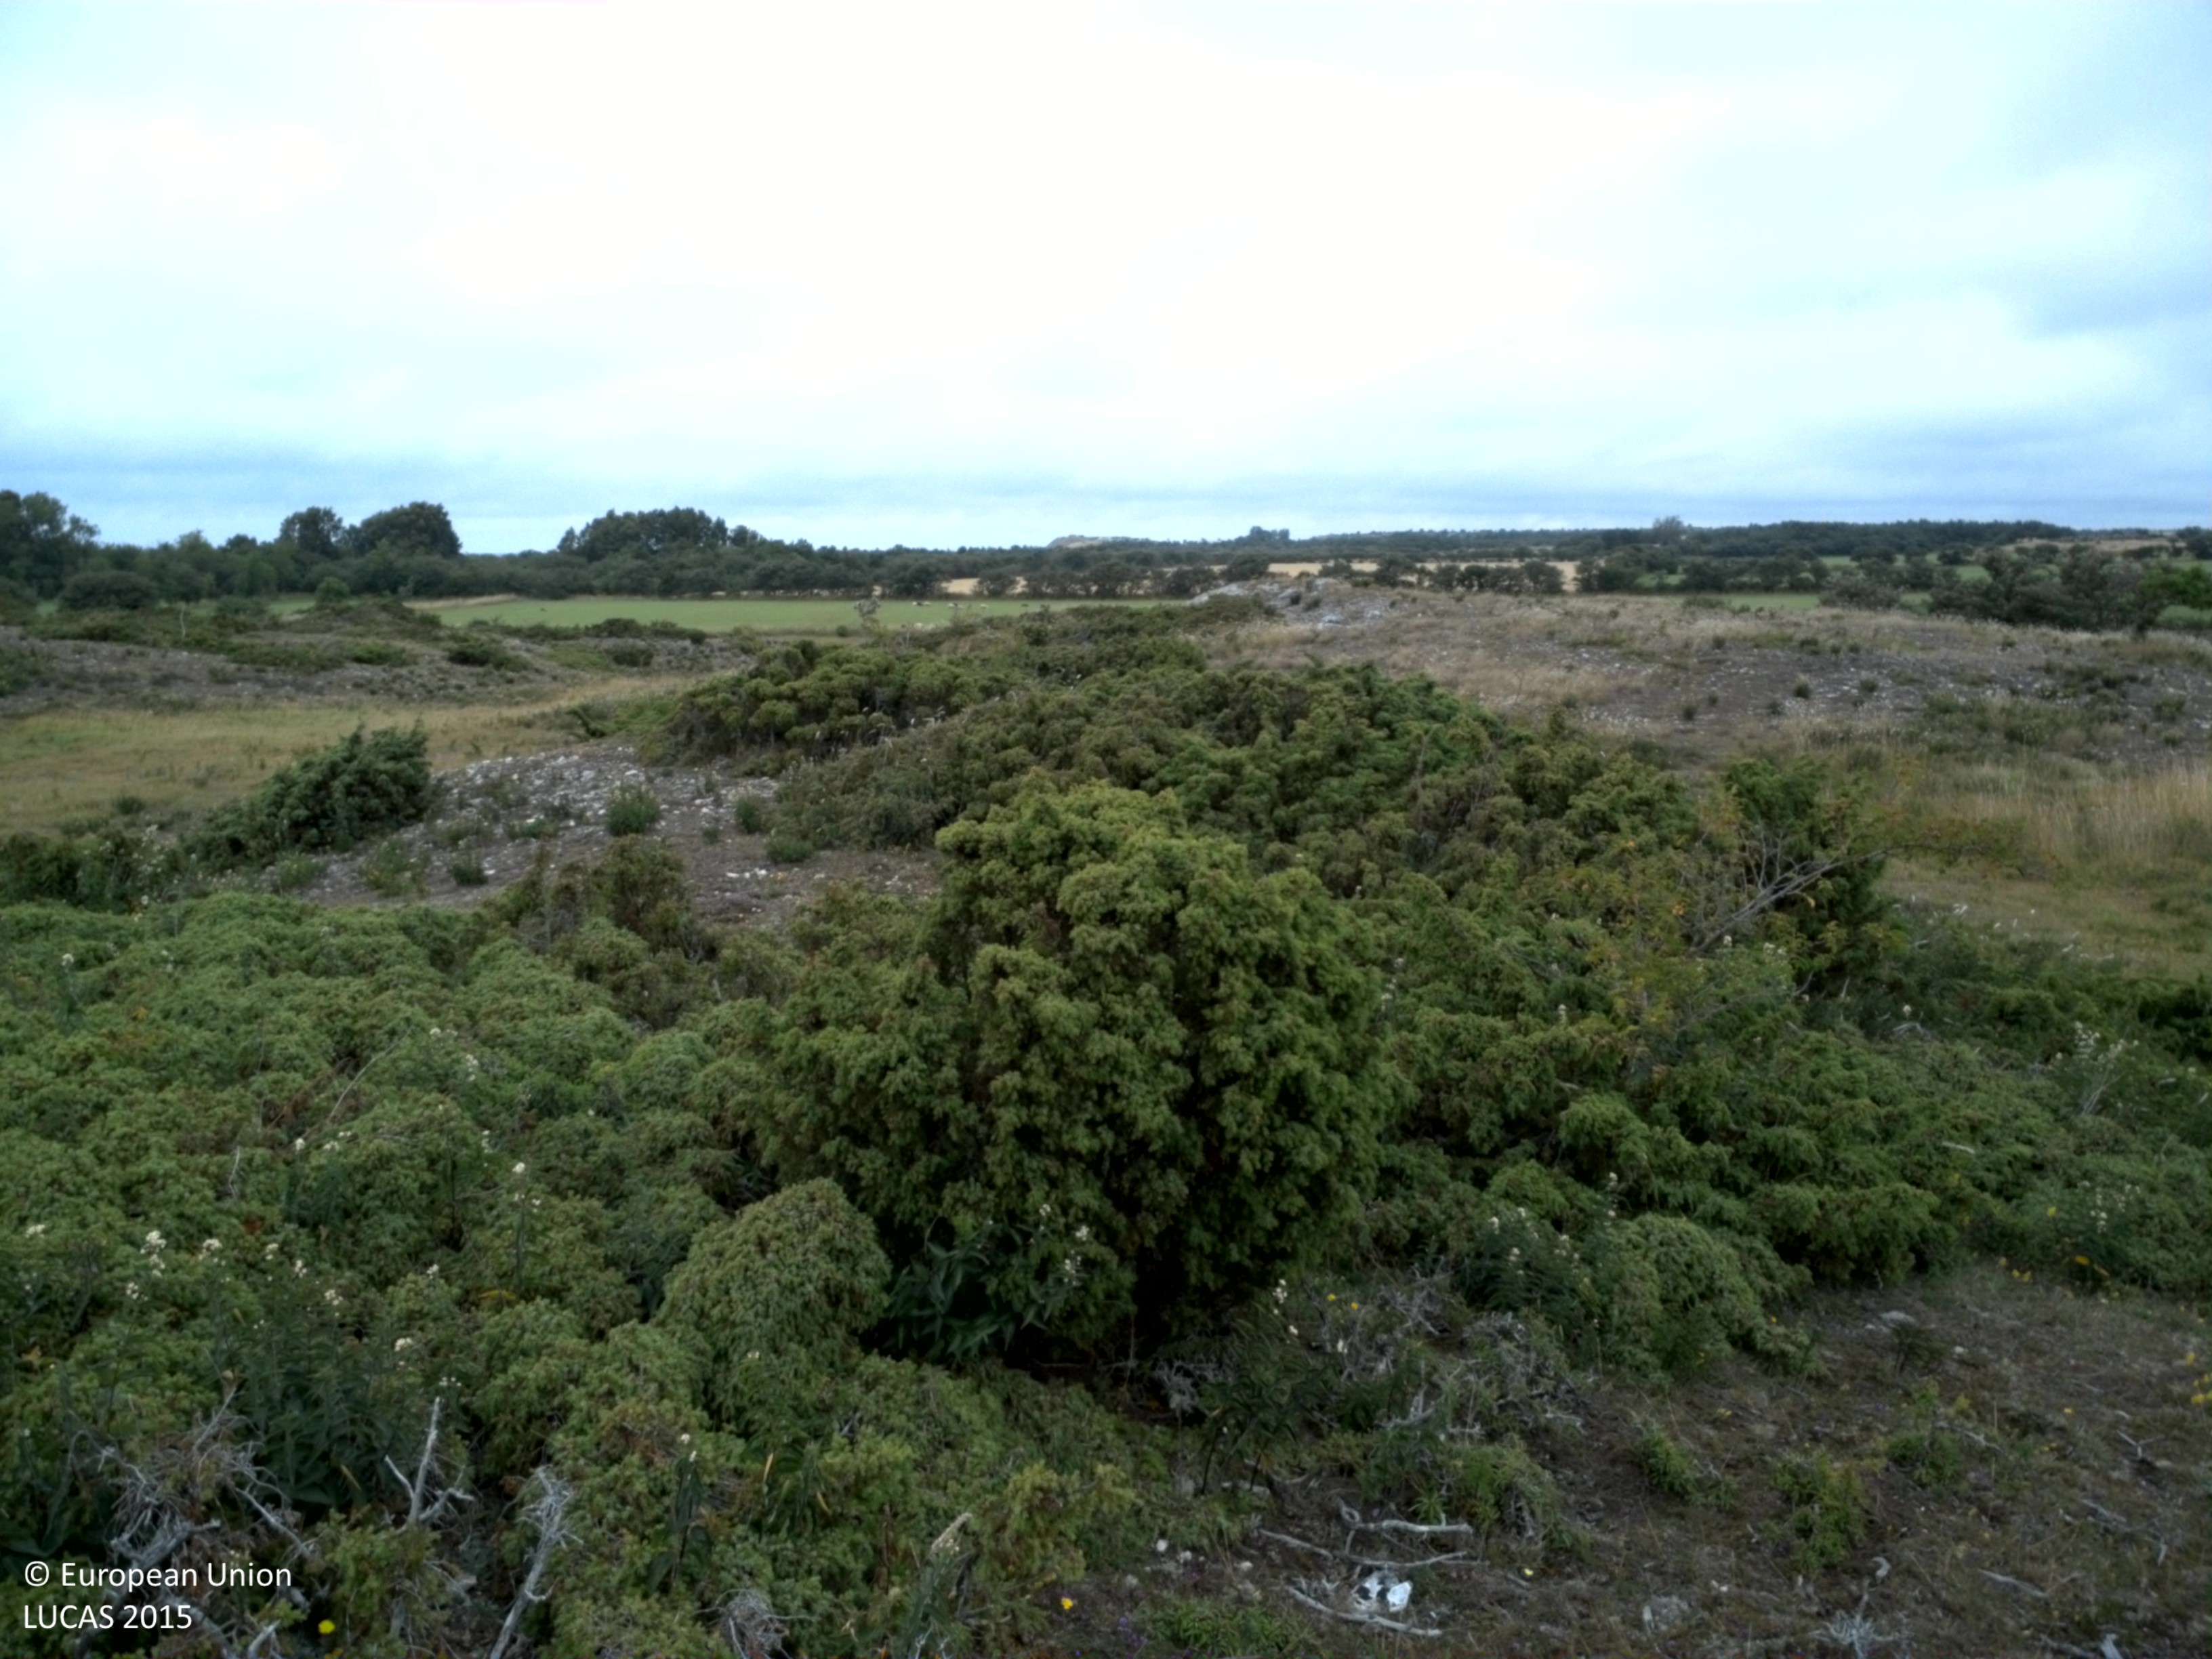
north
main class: Shrubland
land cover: Shrubland without tree cover
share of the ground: 50 - 75 %
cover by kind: shrubs 55 %, herbaceous plants 25 %, lichens and mosses 10 %, unconsolidated bare surface 10 %
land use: Agriculture (excluding fallow land and kitchen gardens)
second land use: Amenities, museums, leisure
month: July
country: SE
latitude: 56.9234
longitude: 18.1407
